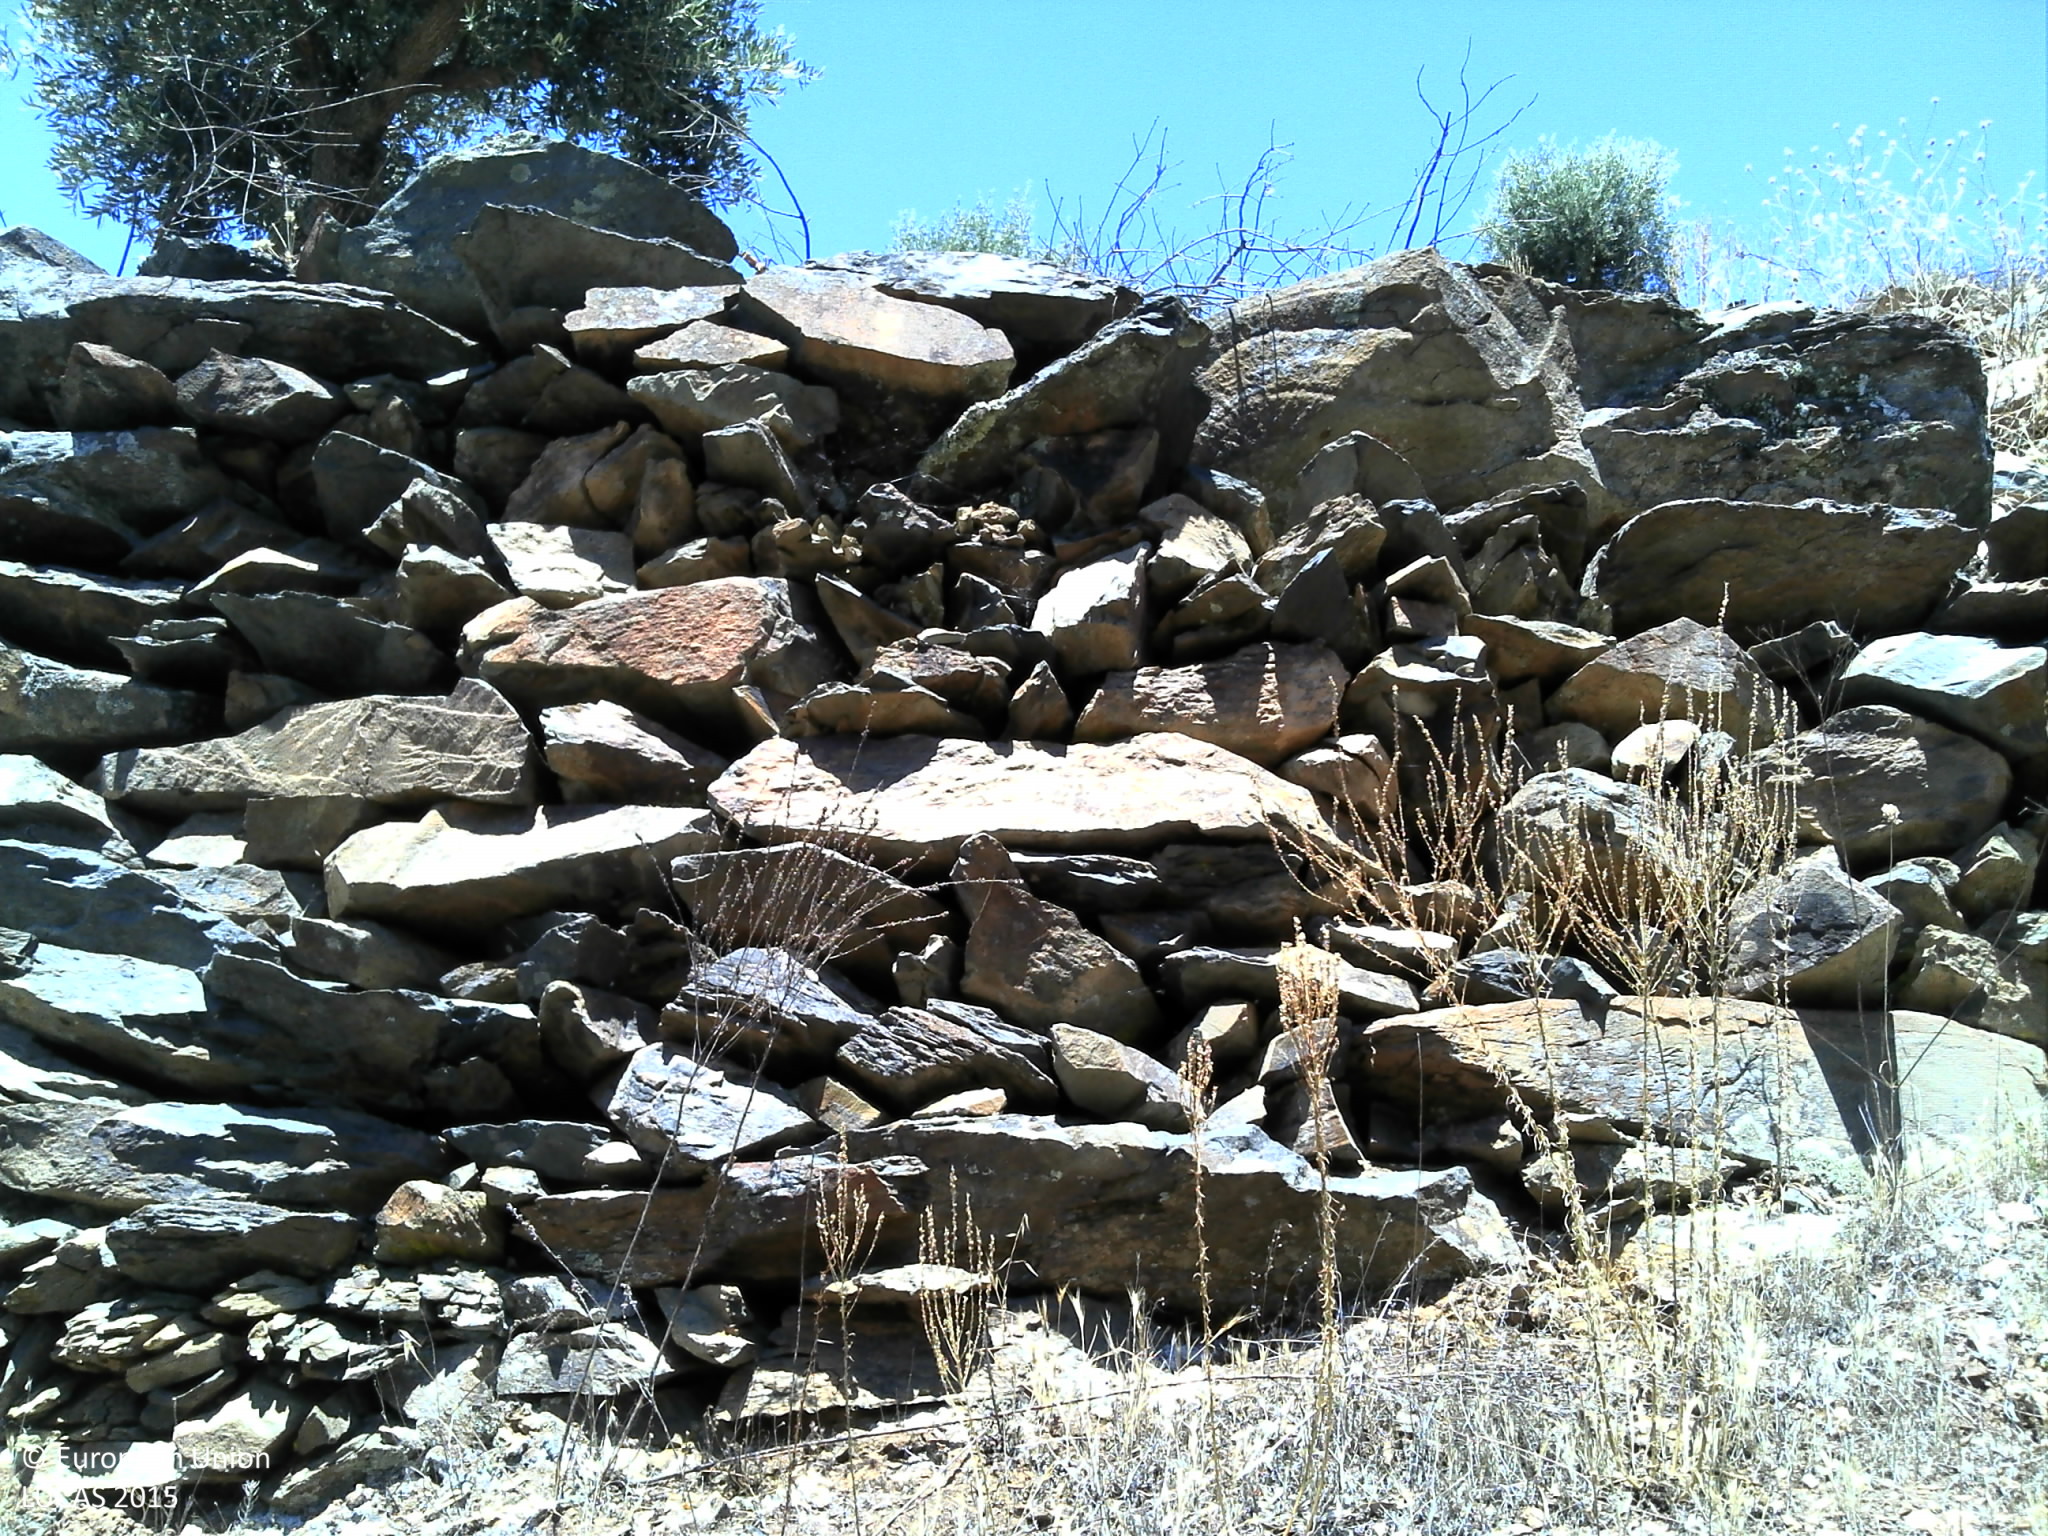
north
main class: Cropland
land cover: Olive groves
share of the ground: 10 - 25 %
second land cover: Grassland without tree/shrub cover
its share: > 75 %
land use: Agriculture (excluding fallow land and kitchen gardens)
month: July
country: PT
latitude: 39.6619
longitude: -7.7855
